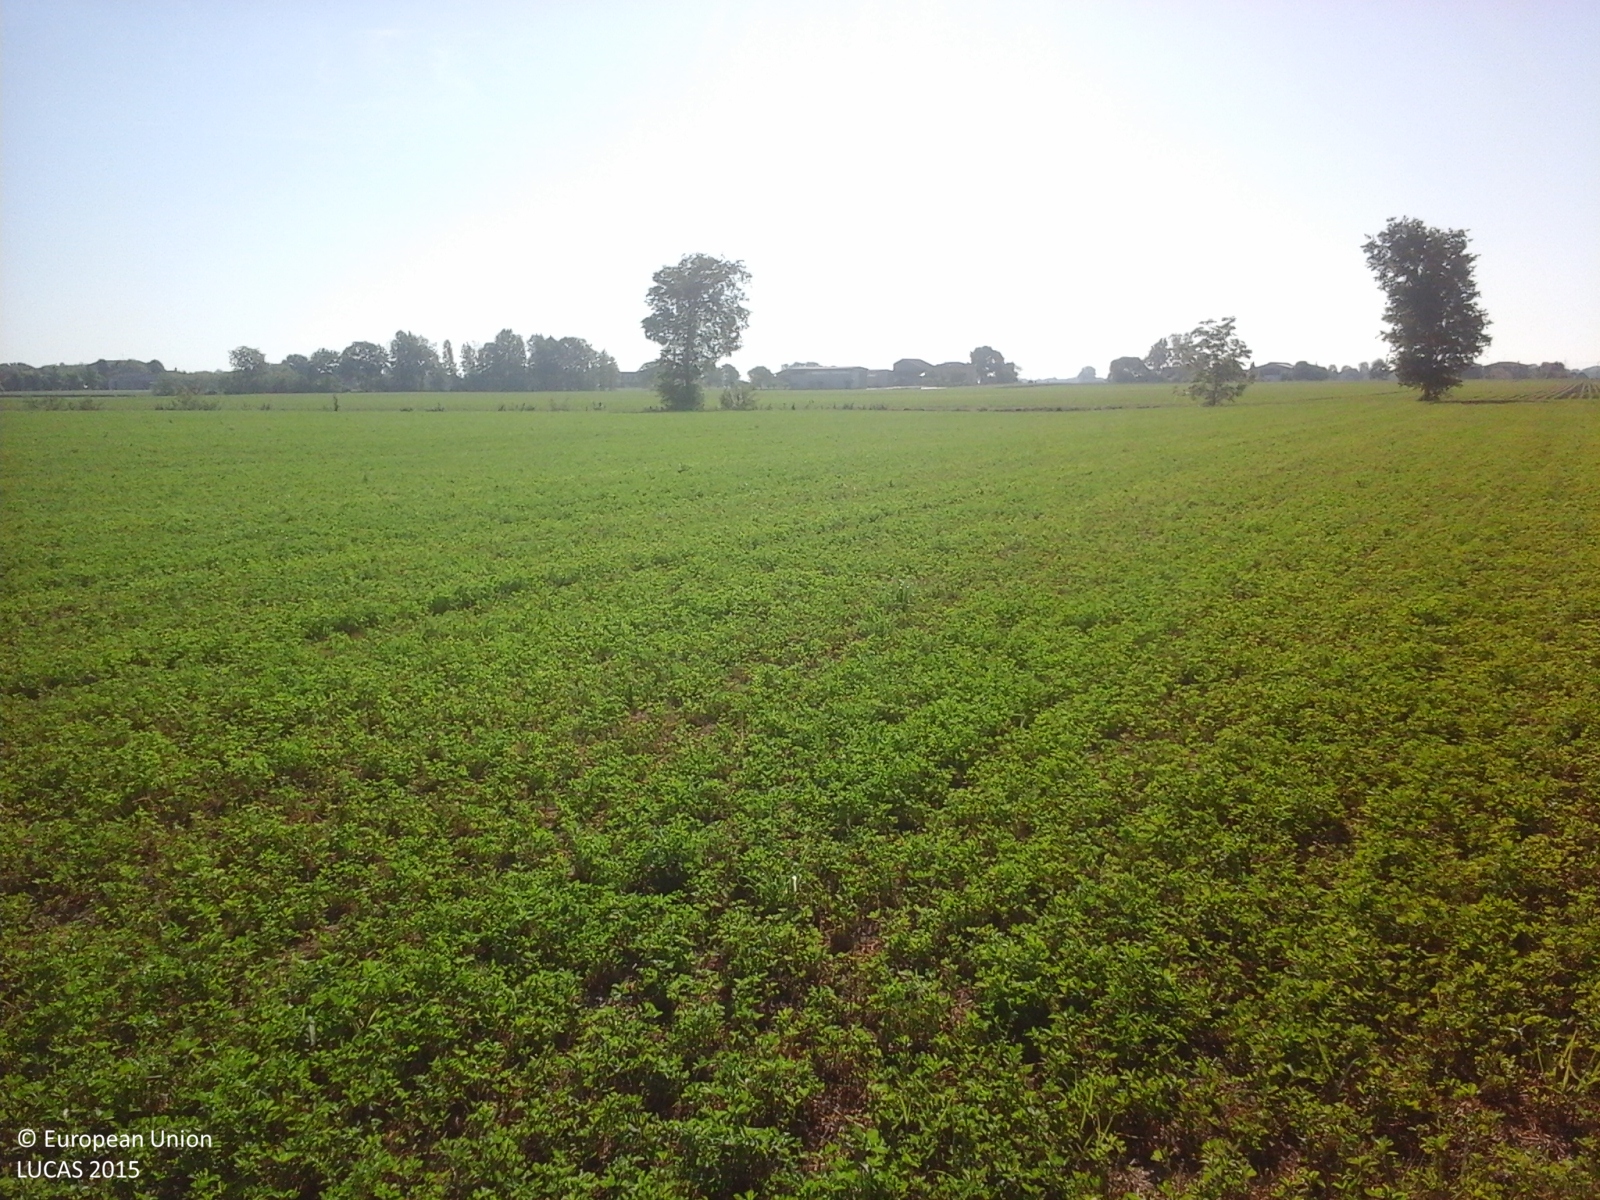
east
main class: Cropland
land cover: Lucerne
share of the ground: > 75 %
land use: Agriculture (excluding fallow land and kitchen gardens)
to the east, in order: Lucerne; Grass margins; Ditches and canals; Grass margins; Tracks; Maize
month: May
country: IT
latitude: 44.9967
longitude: 10.7976
